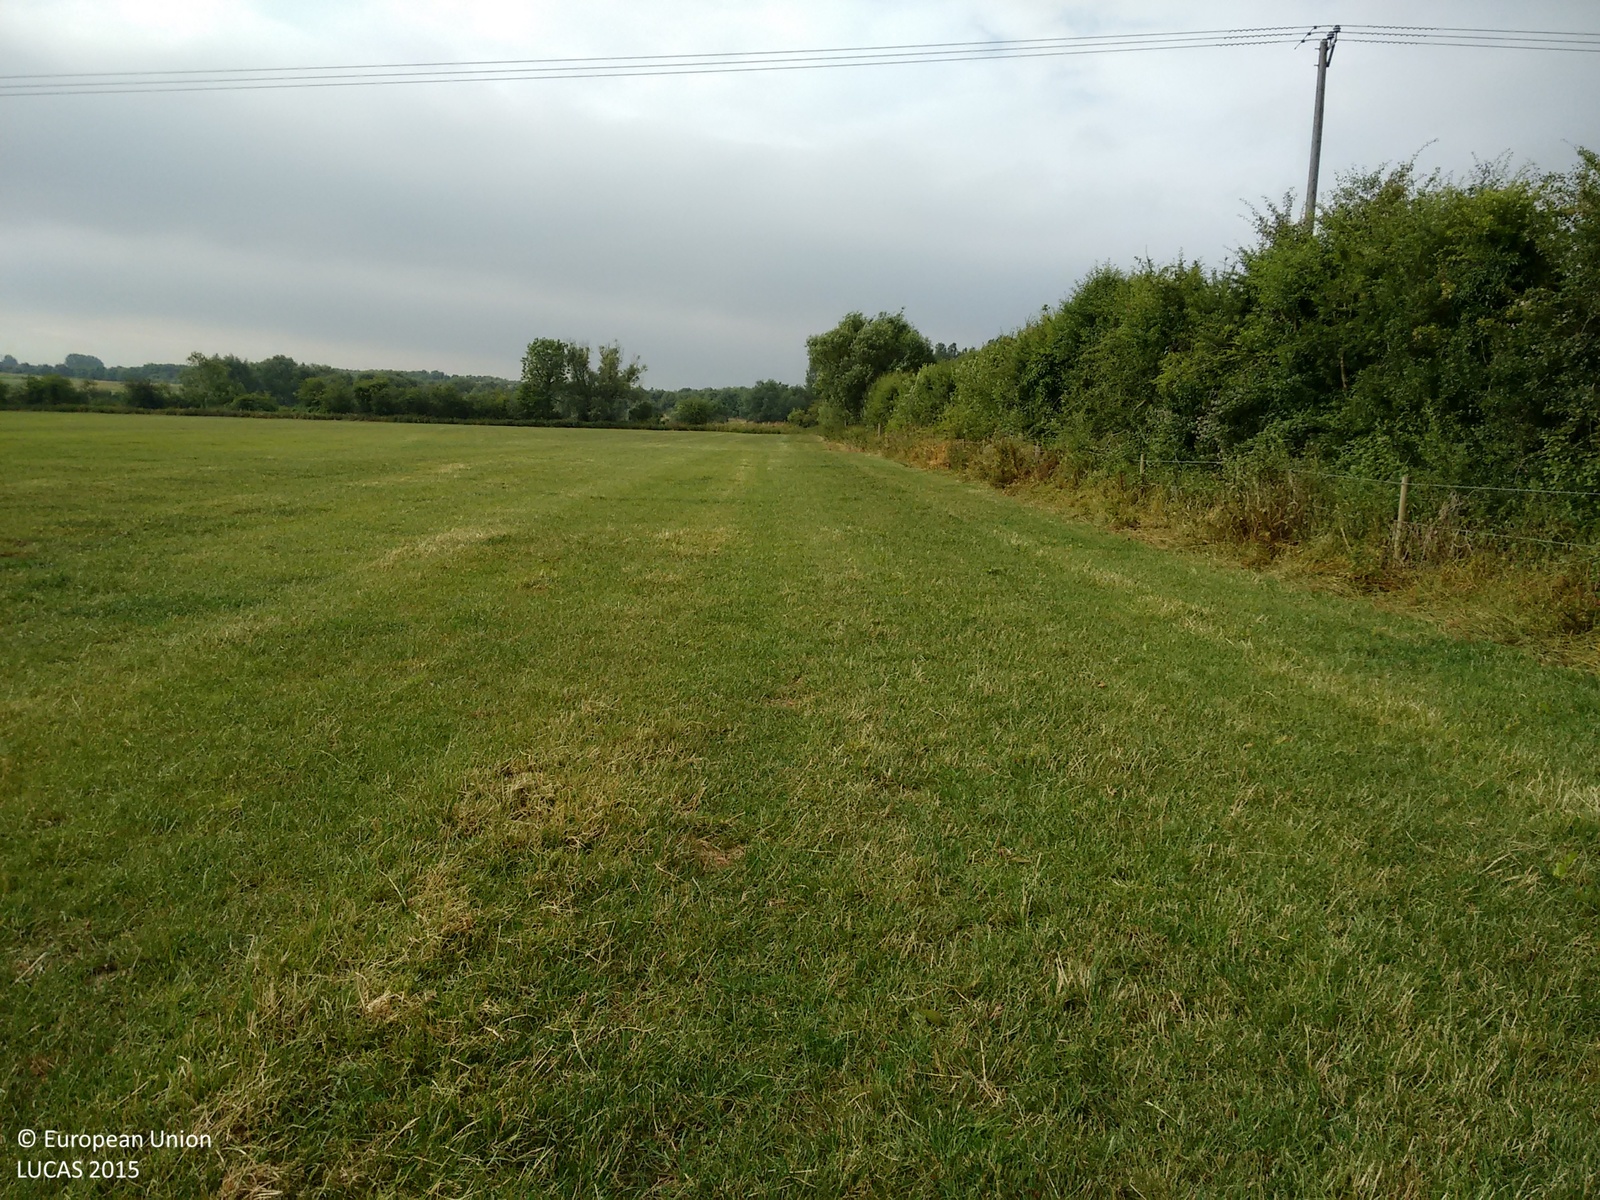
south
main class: Grassland
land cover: Grassland without tree/shrub cover
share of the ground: > 75 %
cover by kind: herbaceous plants 100 %
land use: Agriculture (excluding fallow land and kitchen gardens)
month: July
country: GB
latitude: 51.7465
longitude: -1.0970
